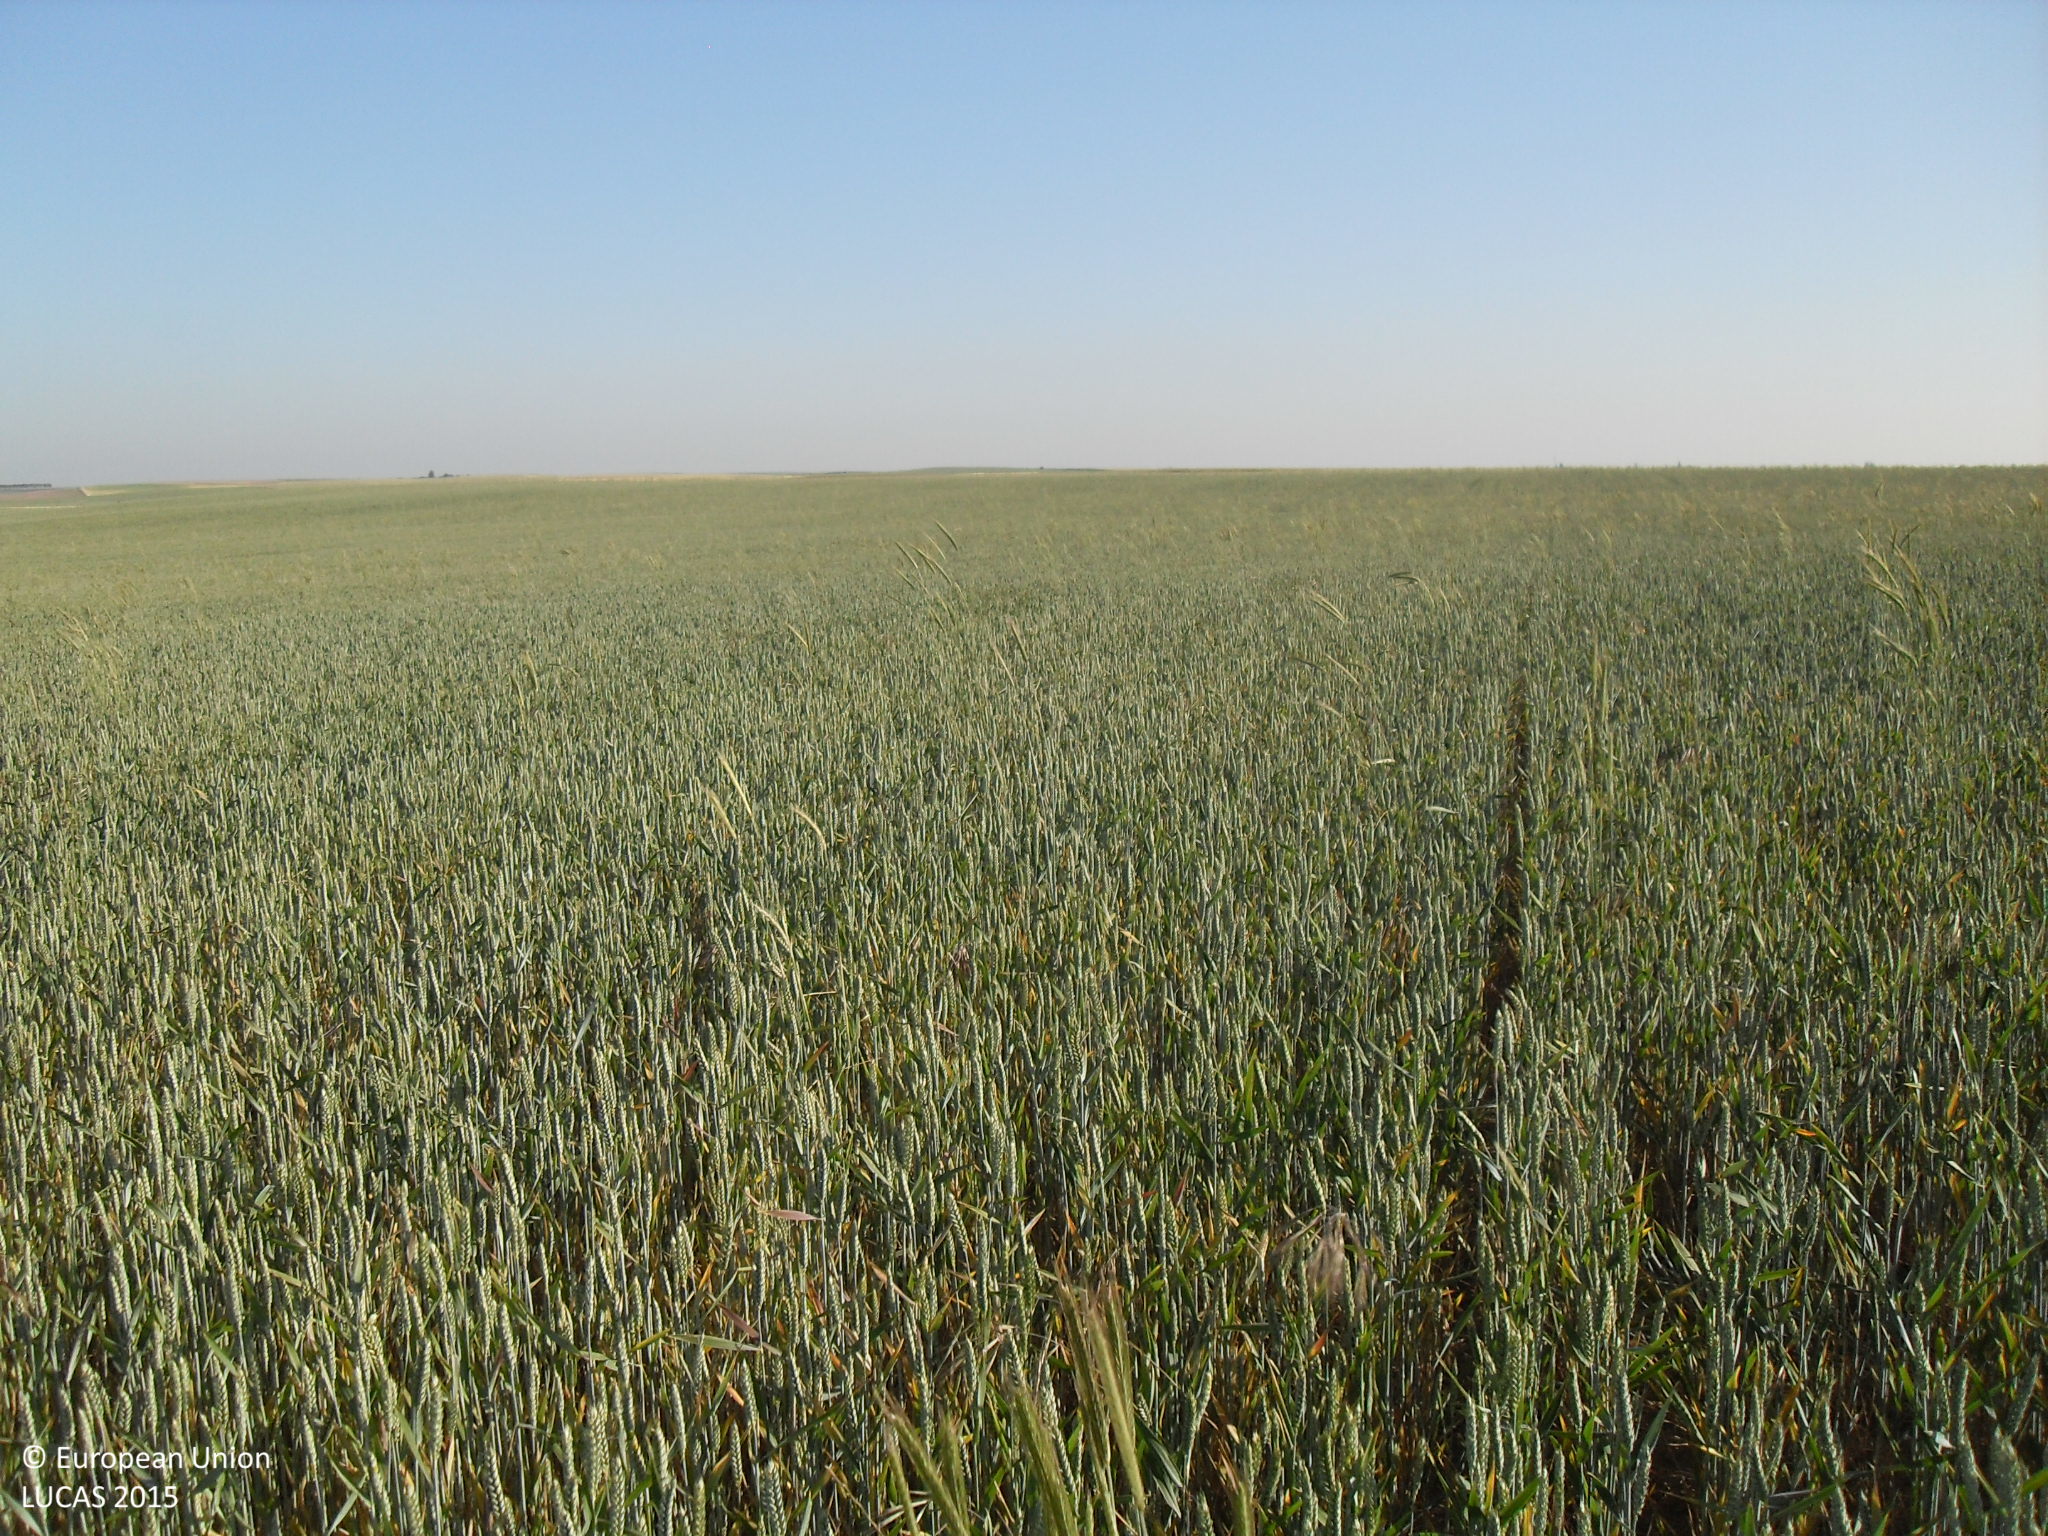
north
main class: Cropland
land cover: Common wheat
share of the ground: > 75 %
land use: Agriculture (excluding fallow land and kitchen gardens)
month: May
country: ES
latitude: 41.0774
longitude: -5.1979
